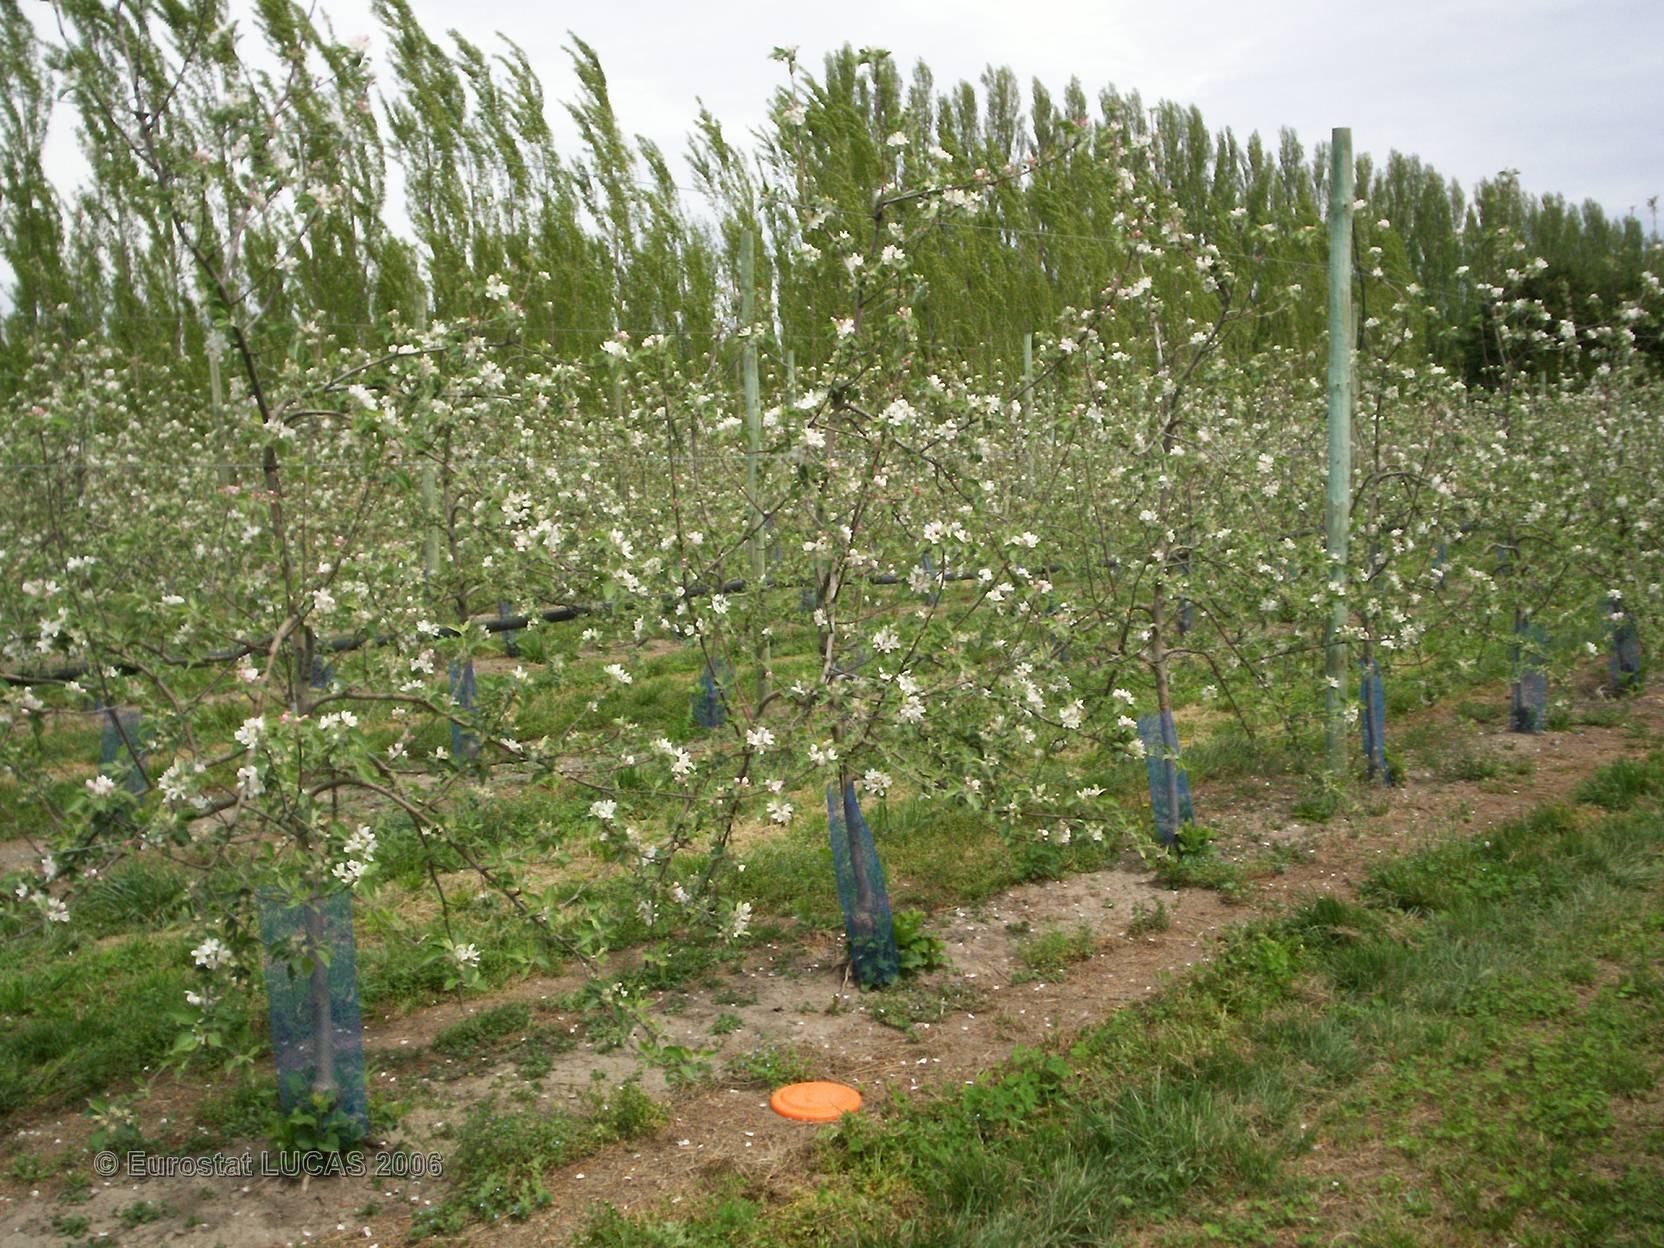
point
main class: Cropland
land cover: Apple fruit
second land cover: Grassland with sparse tree/shrub cover
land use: Agriculture (excluding fallow land and kitchen gardens)
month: April
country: FR
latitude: 43.7927
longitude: 4.9261
